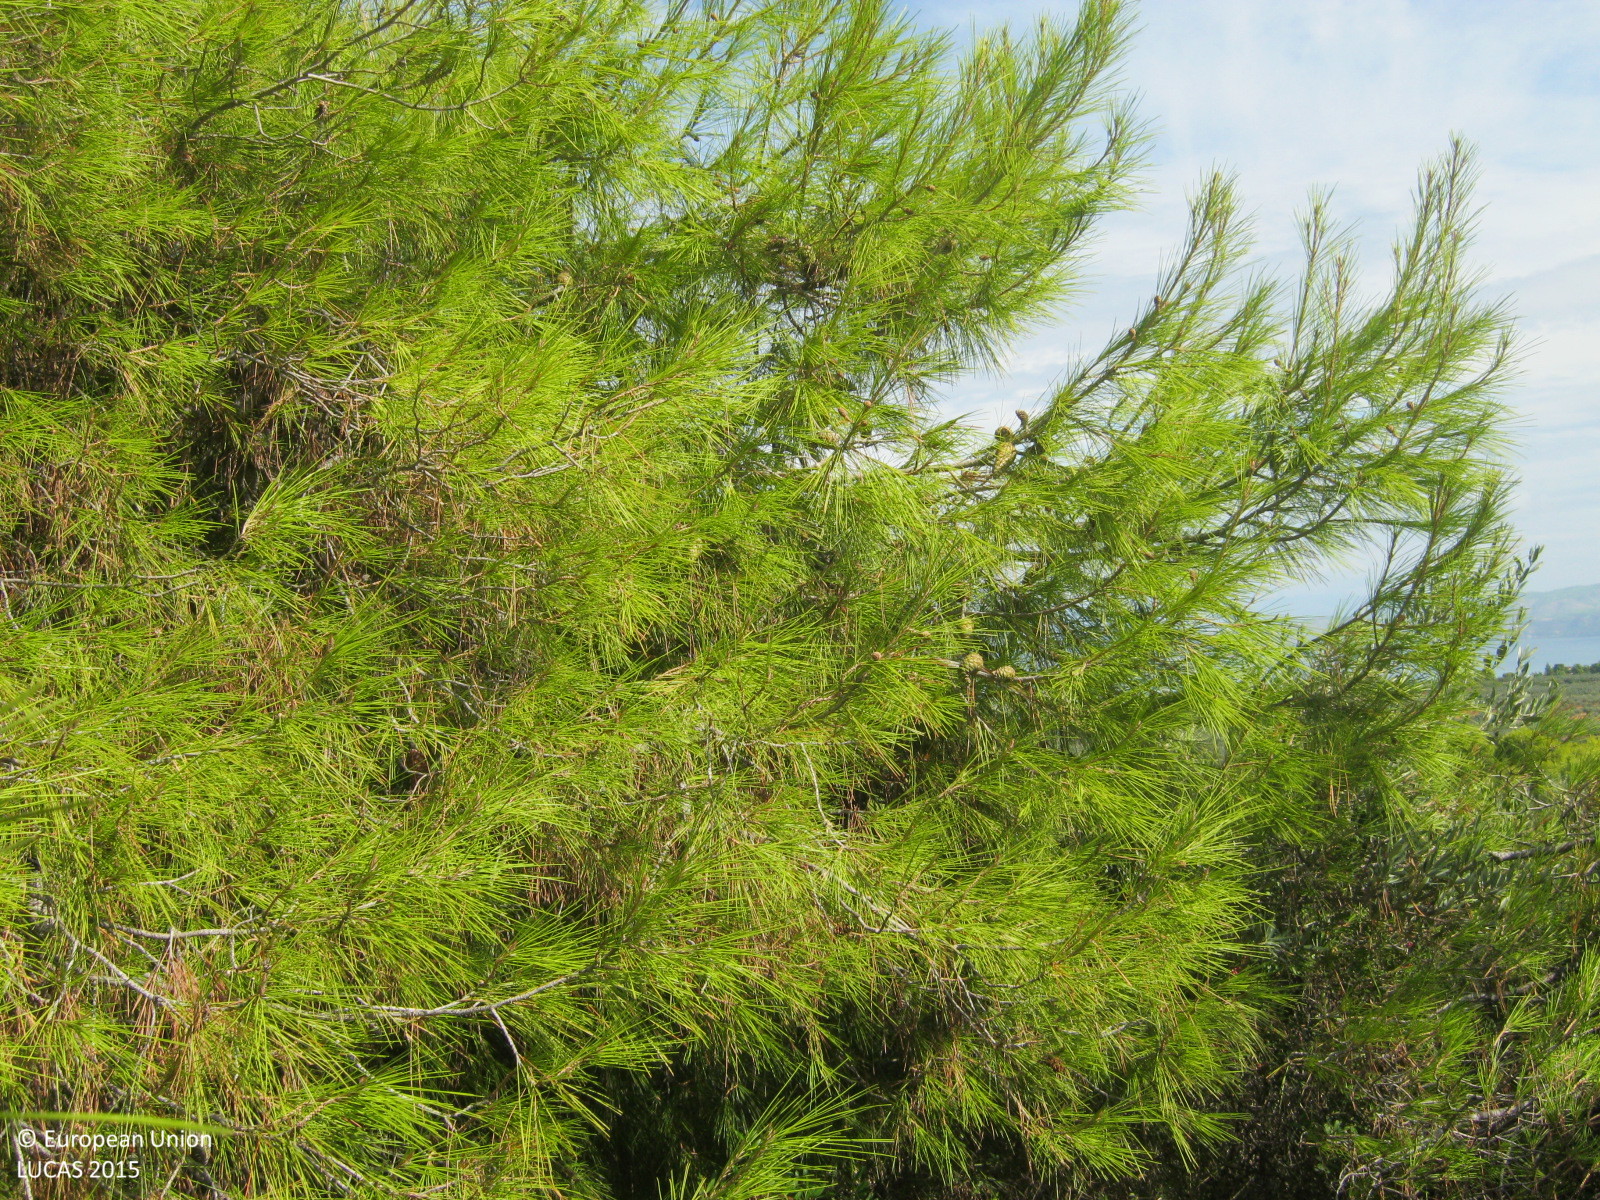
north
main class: Woodland
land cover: Pine dominated coniferous woodland
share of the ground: > 75 %
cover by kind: coniferous forest trees 85 %, shrubs 15 %
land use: Semi-natural and natural areas not in use
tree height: > 5 m
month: September
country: GR
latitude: 37.8830
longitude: 22.8298
